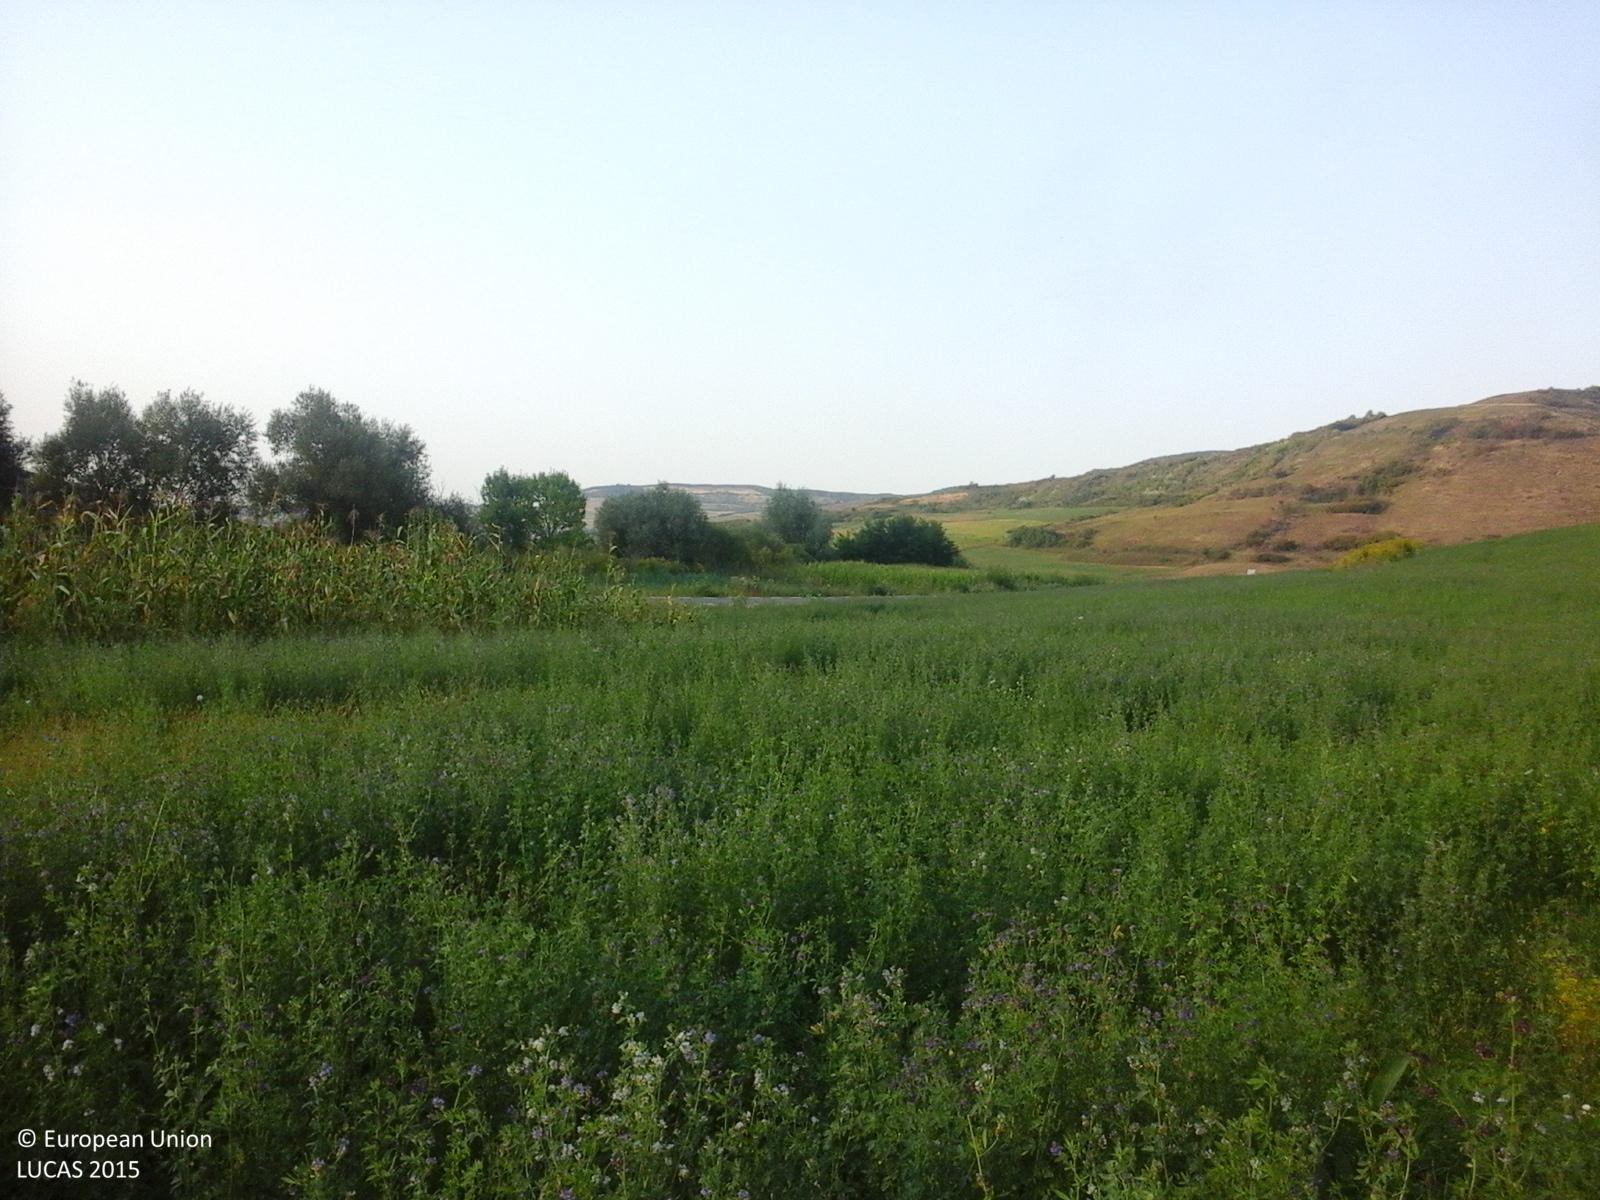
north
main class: Shrubland
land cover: Shrubland with sparse tree cover
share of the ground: > 75 %
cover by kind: shrubs 95 %, broadleaved forest trees 5 %
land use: Fallow land
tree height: > 5 m
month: September
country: RO
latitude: 47.0065
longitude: 24.1969
